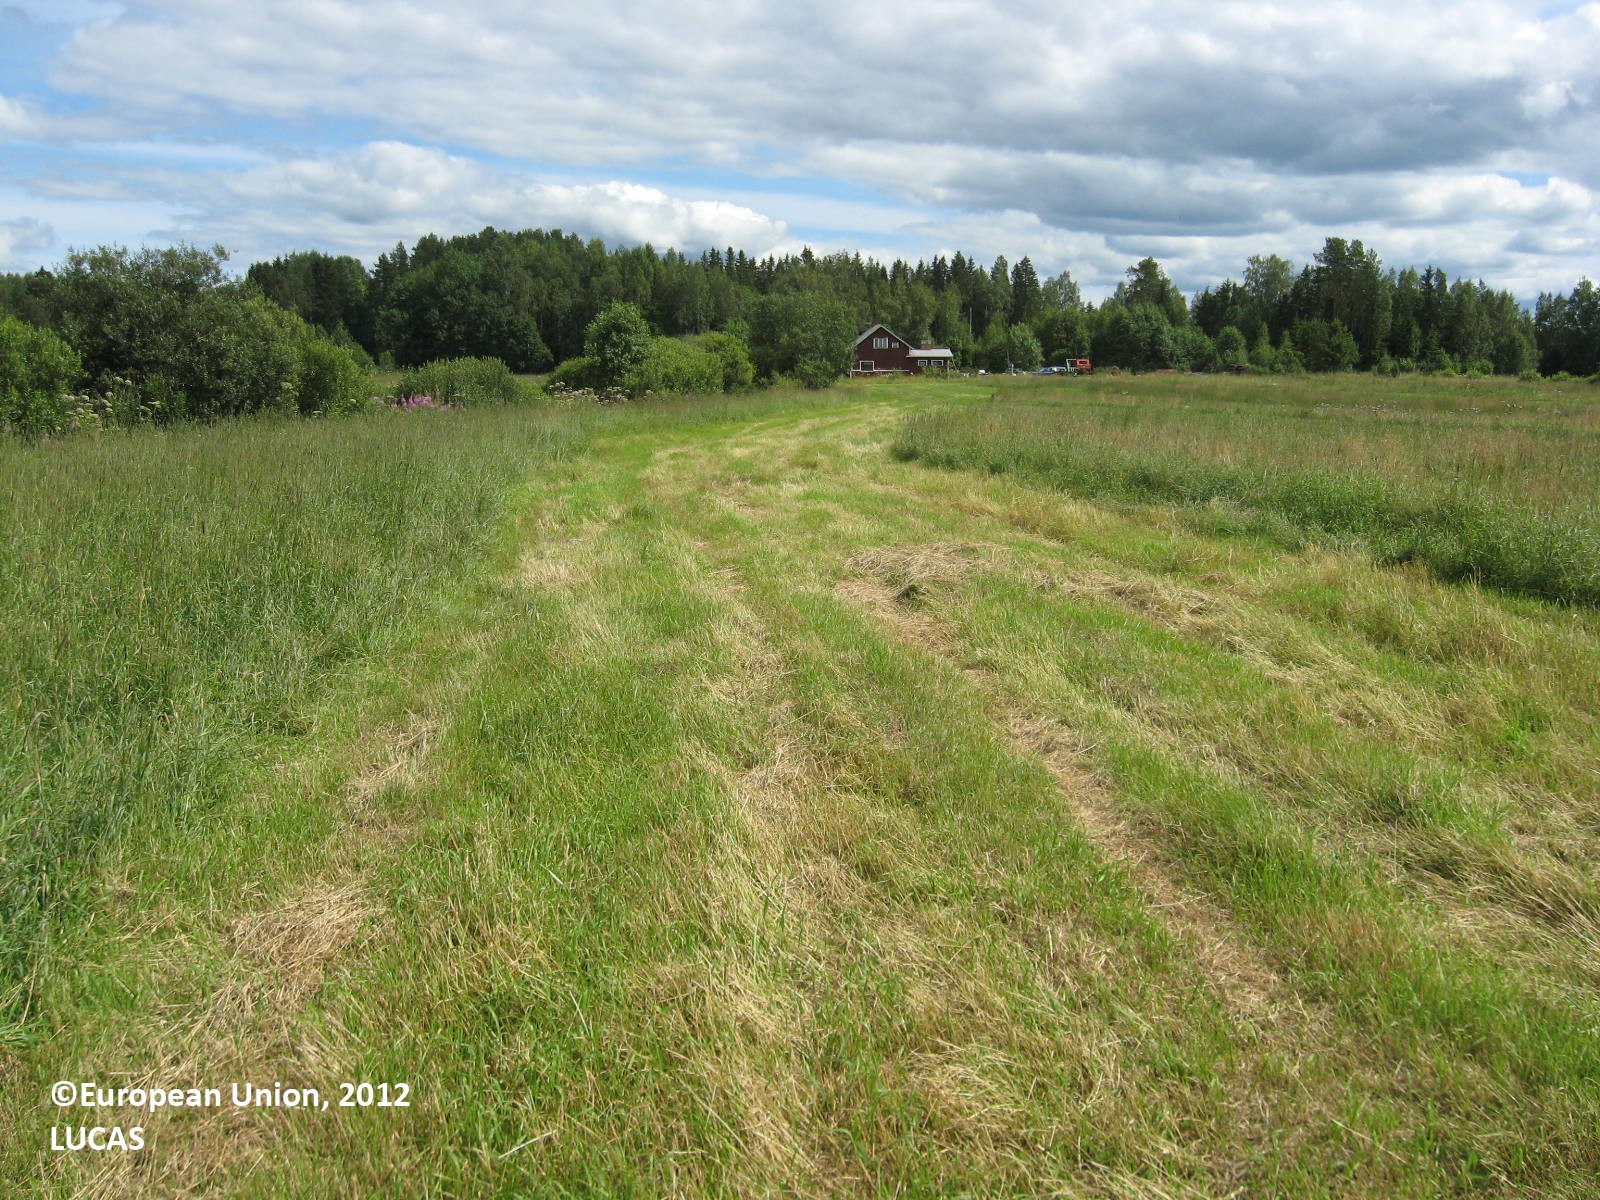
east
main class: Cropland
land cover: Temporary grasslands
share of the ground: > 75 %
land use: Agriculture (excluding fallow land and kitchen gardens)
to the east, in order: Temporary grasslands; Grass margins; Broadleaved woodland; Grass margins; Temporary grasslands; Grass margins; Grassland with sparse tree/shrub cover; Artificial constructions in urban areas; Ditches and canals; Spruce dominated mixed woodland; Broadleaved woodland
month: July
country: FI
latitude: 62.0528
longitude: 22.2783
